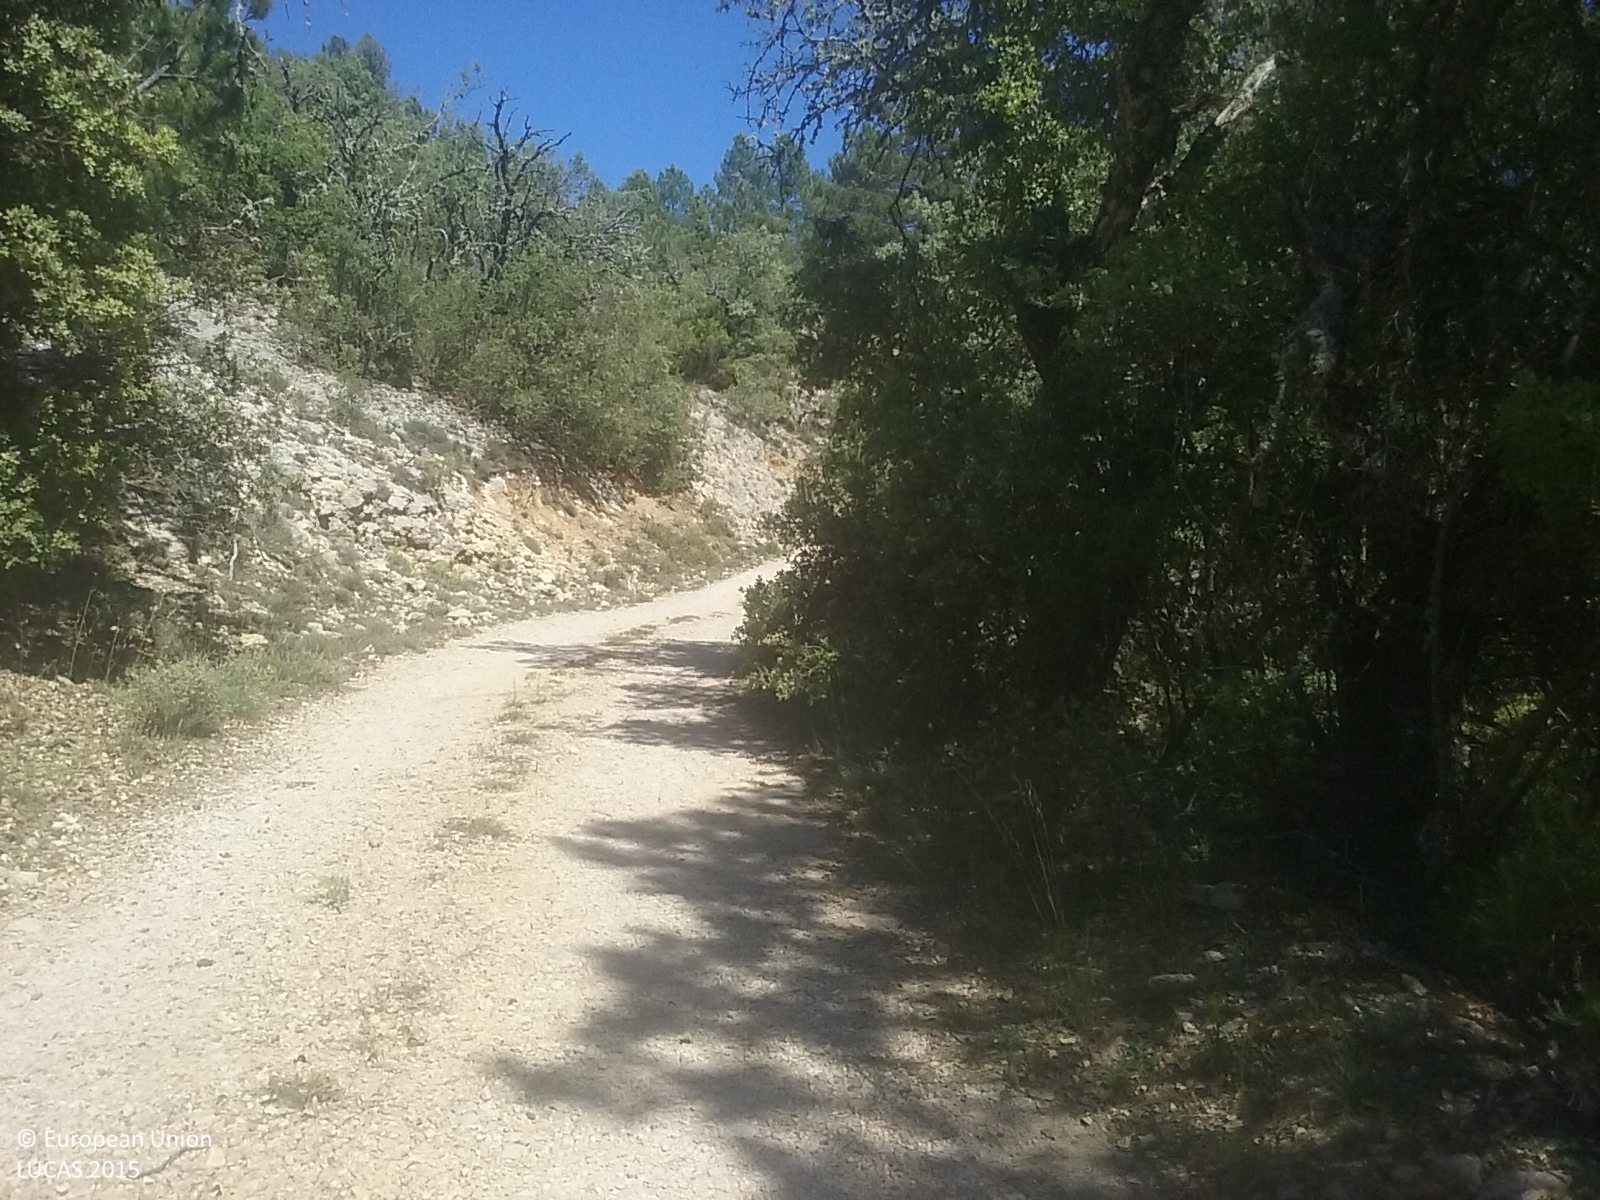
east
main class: Woodland
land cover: Pine dominated mixed woodland
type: coniferous forest of the mediterranean region
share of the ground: > 75 %
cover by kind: coniferous forest trees 40 %, broadleaved forest trees 40 %, shrubs 10 %, unconsolidated bare surface 10 %
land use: Forestry
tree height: > 5 m
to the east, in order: Pine dominated mixed woodland; Shrubland with sparse tree cover; Pine dominated mixed woodland
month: June
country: ES
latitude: 40.6453
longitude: -0.0232
